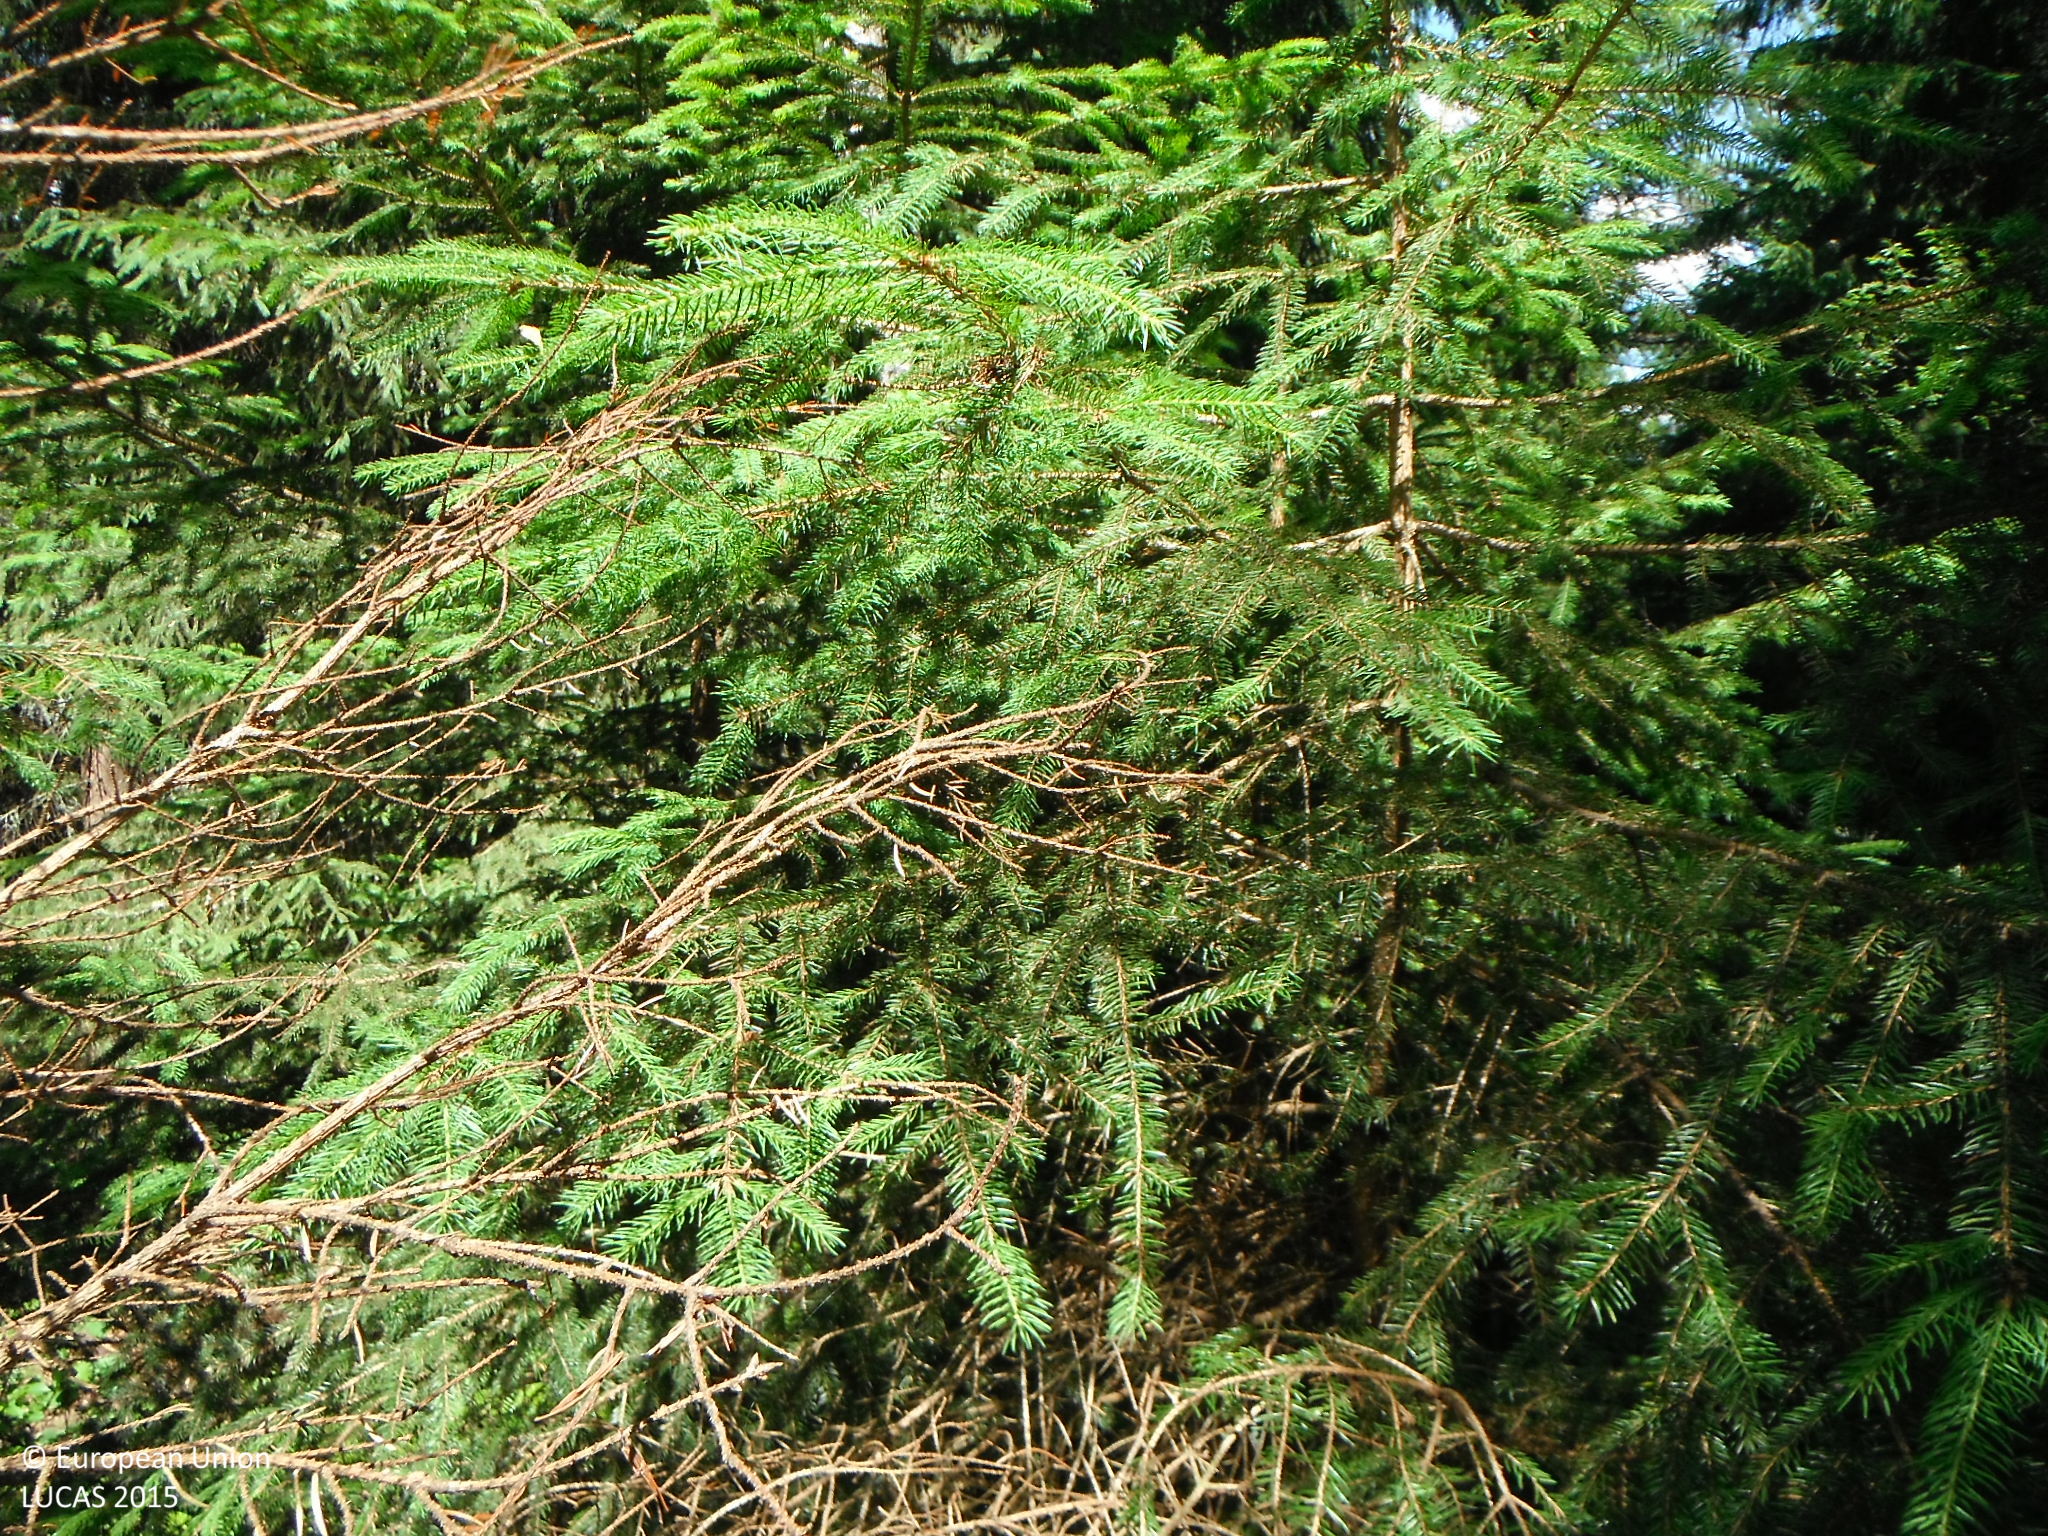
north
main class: Woodland
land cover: Spruce dominated coniferous woodland
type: alpine coniferous forest
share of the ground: > 75 %
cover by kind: coniferous forest trees 80 %, broadleaved forest trees 20 %
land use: Forestry
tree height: > 5 m
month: July
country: SK
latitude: 49.3494
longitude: 19.3166
